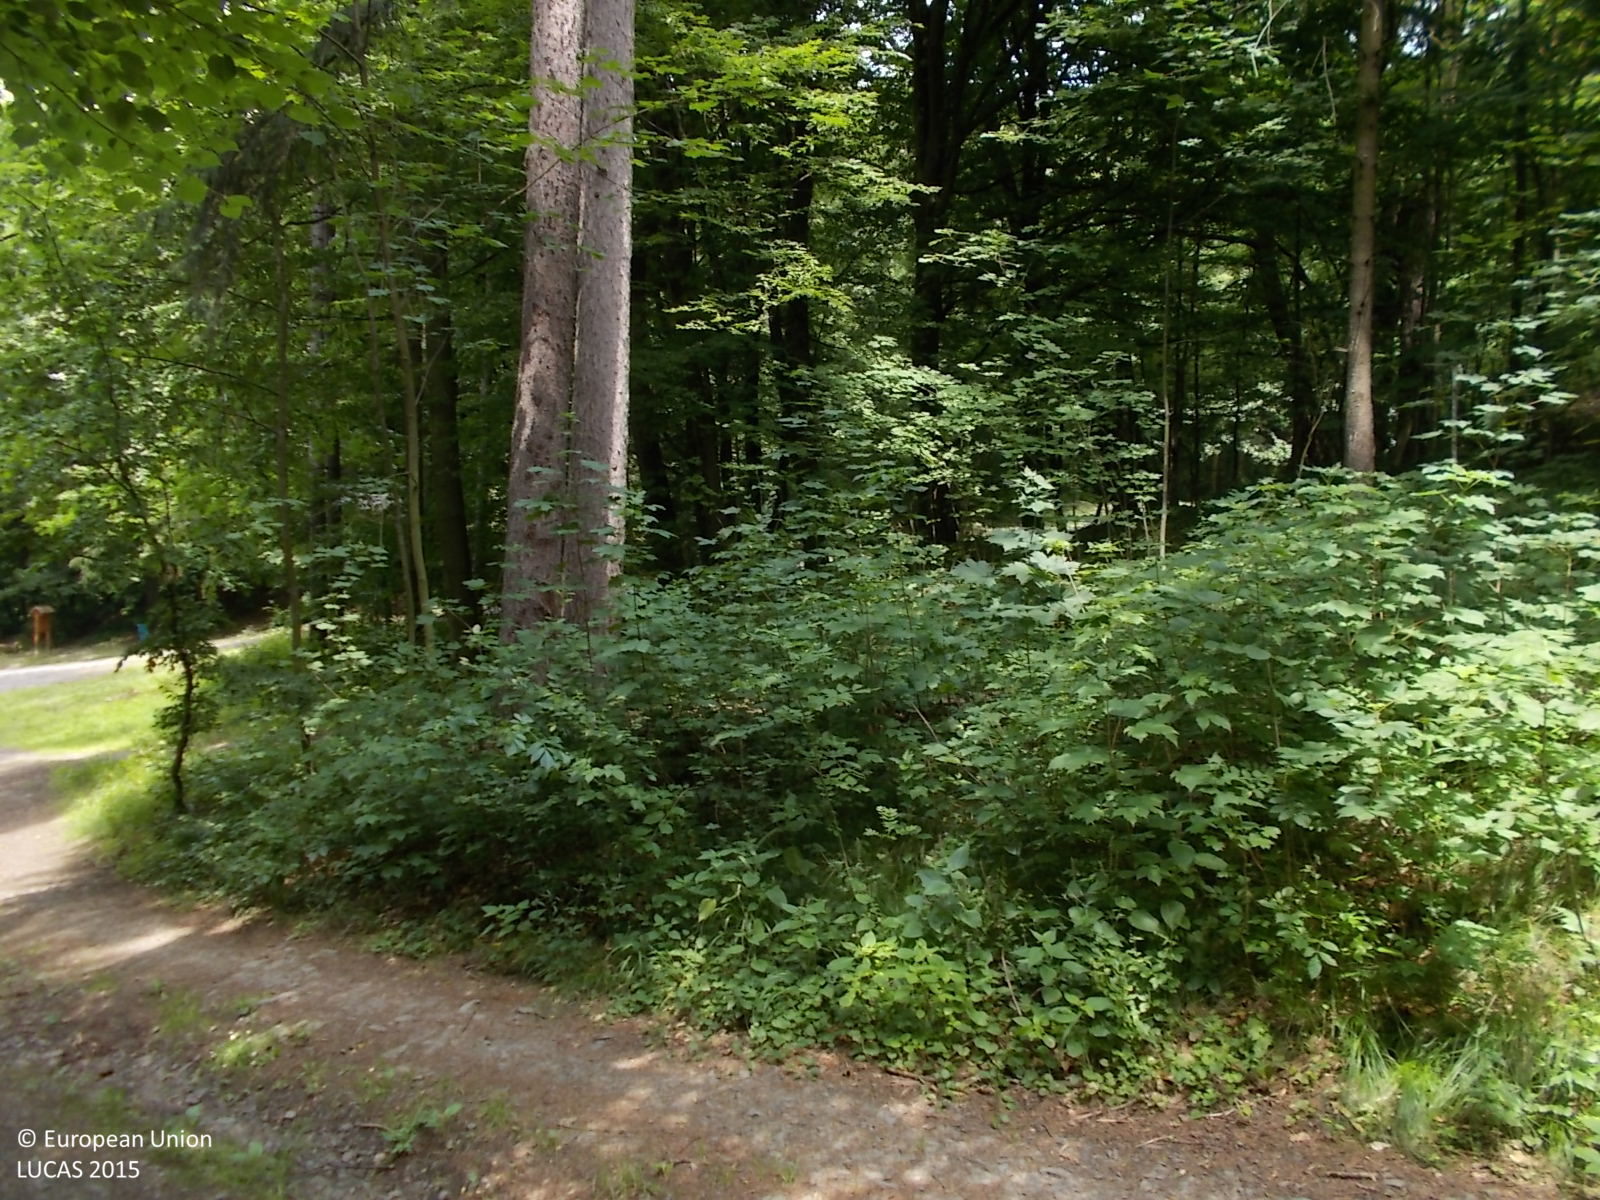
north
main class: Woodland
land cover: Spruce dominated mixed woodland
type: hemiboreal forest and nemoral coniferous forest and mixed broadleaved-coniferous forest
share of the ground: > 75 %
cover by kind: broadleaved forest trees 40 %, coniferous forest trees 30 %, unconsolidated bare surface 15 %, herbaceous plants 10 %, shrubs 5 %
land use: Forestry
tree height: > 5 m
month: June
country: CZ
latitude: 49.5134
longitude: 17.6230
